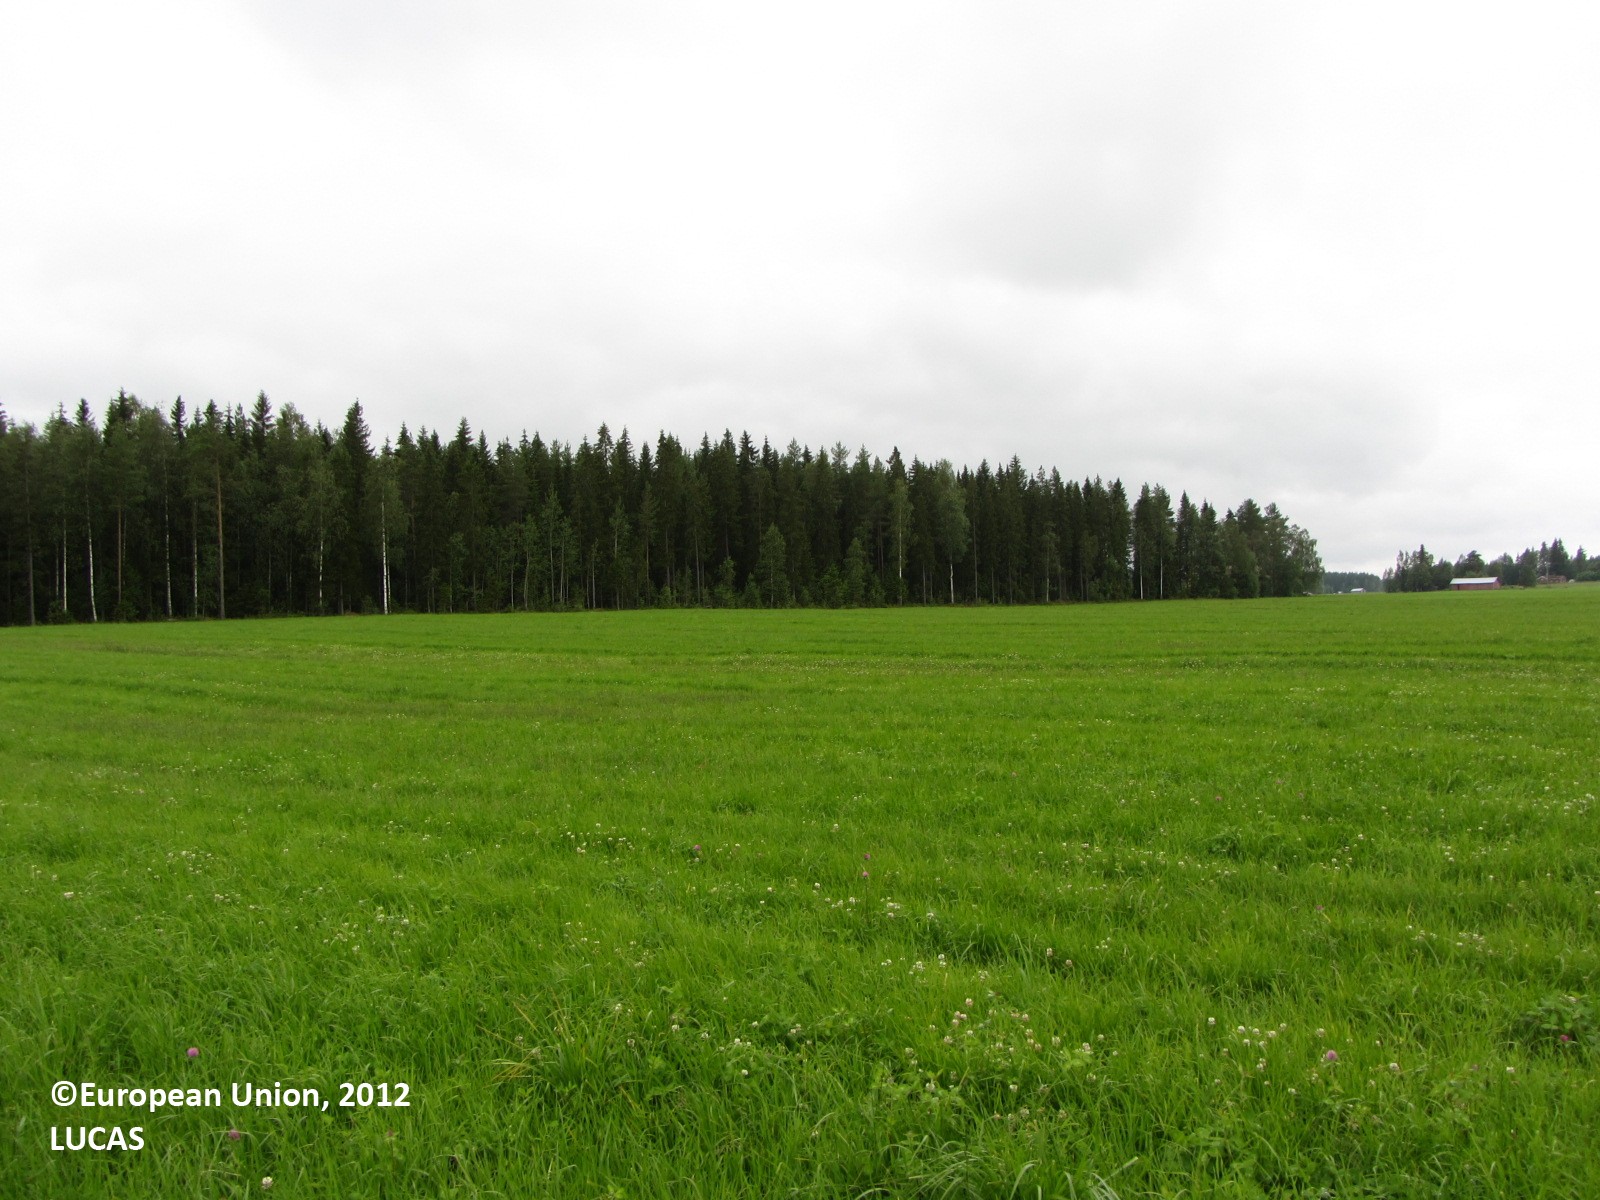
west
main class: Cropland
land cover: Temporary grasslands
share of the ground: > 75 %
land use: Agriculture (excluding fallow land and kitchen gardens)
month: July
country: FI
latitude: 63.9219
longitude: 24.7815
